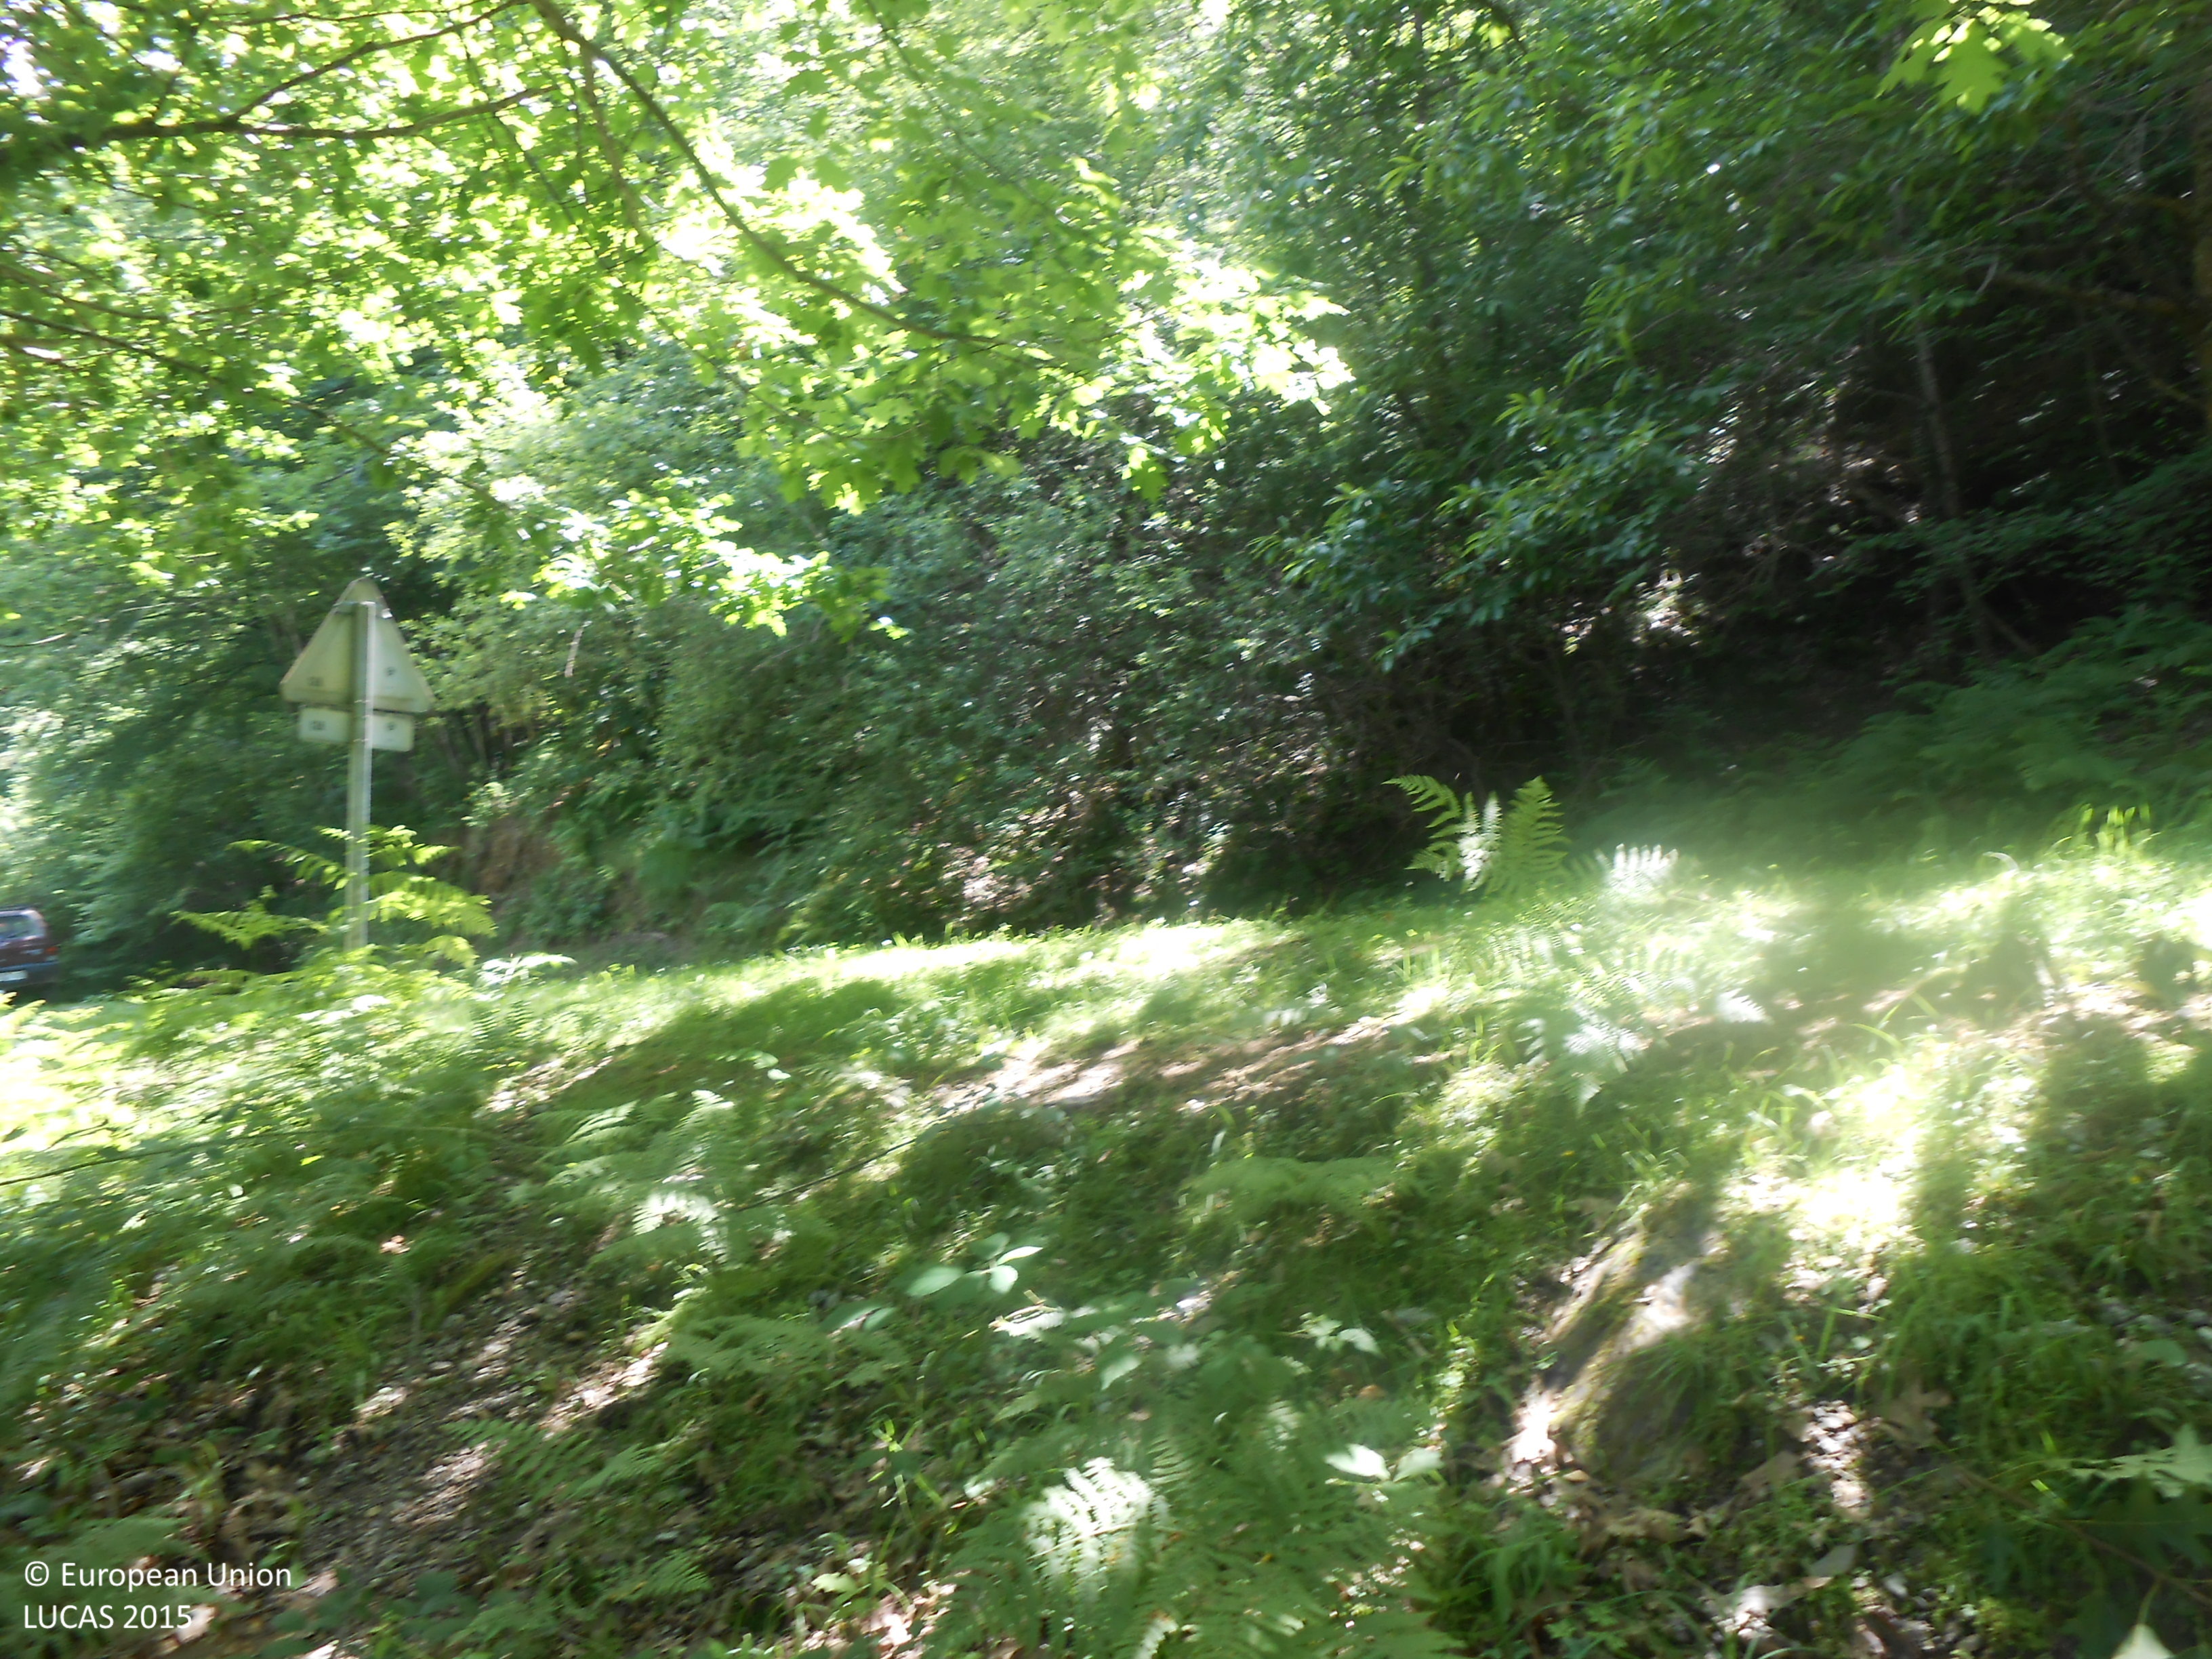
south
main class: Woodland
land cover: Broadleaved woodland
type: acidophilous oak and oak-birch forest
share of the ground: > 75 %
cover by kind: broadleaved forest trees 95 %, herbaceous plants 5 %
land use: Forestry
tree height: > 5 m
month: June
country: ES
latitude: 43.1910
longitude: -1.5713
